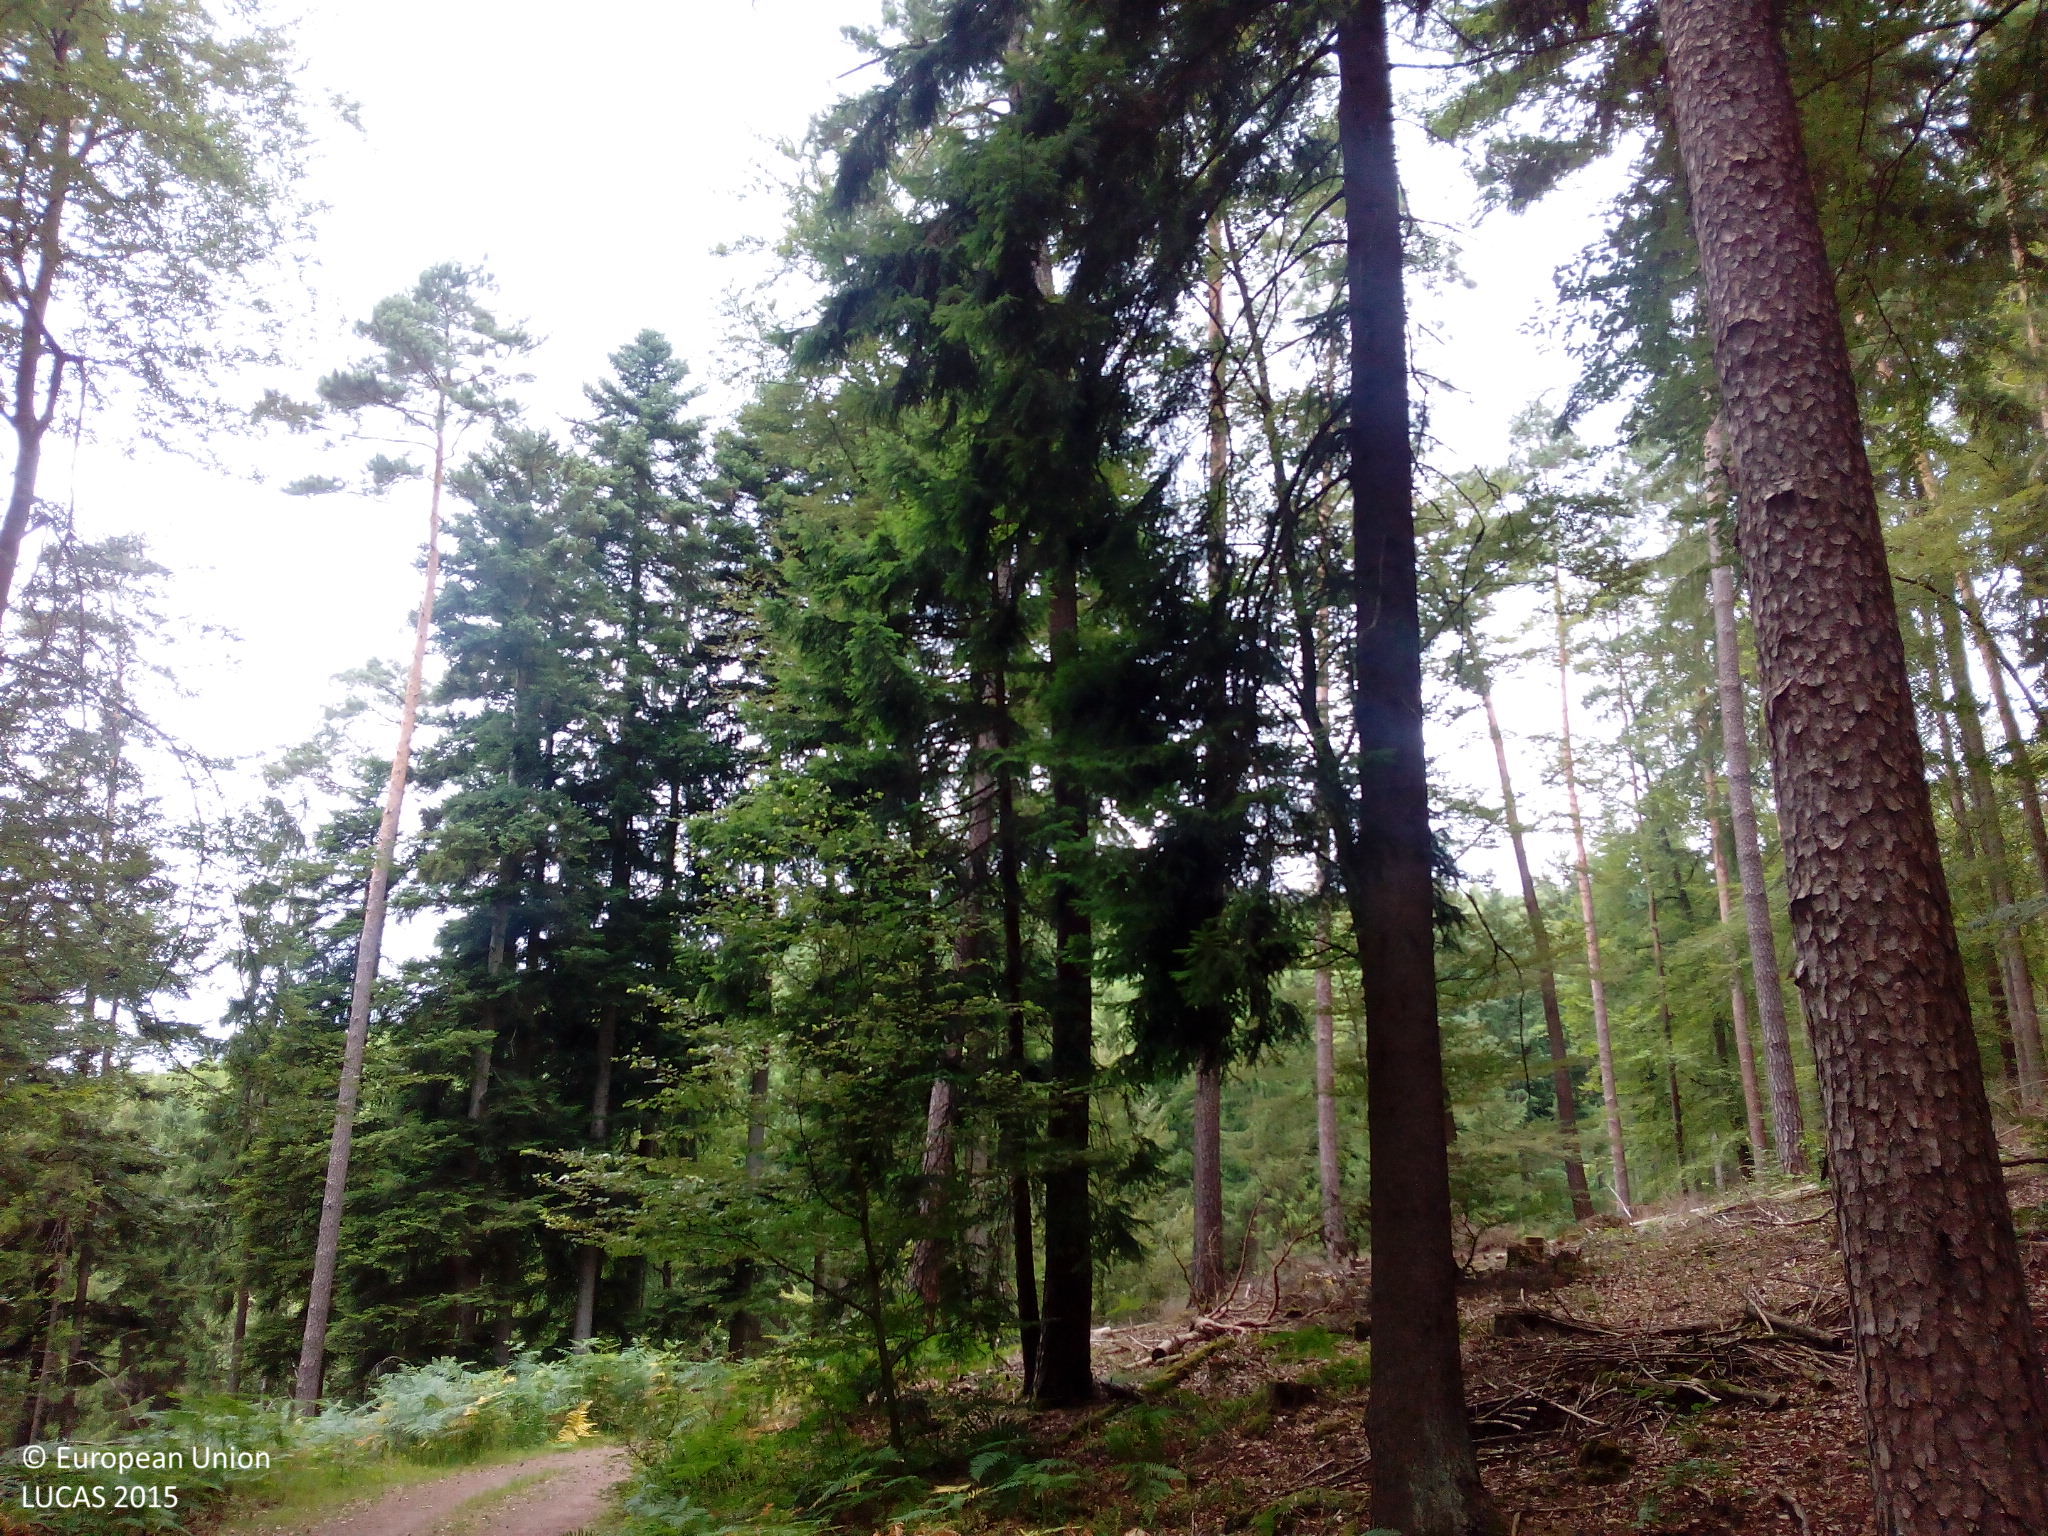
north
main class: Woodland
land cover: Other mixed woodland
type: hemiboreal forest and nemoral coniferous forest and mixed broadleaved-coniferous forest
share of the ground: > 75 %
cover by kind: coniferous forest trees 60 %, broadleaved forest trees 25 %, unconsolidated bare surface 10 %, herbaceous plants 5 %
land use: Forestry
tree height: > 5 m
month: July
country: DE
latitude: 49.1155
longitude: 7.6030
